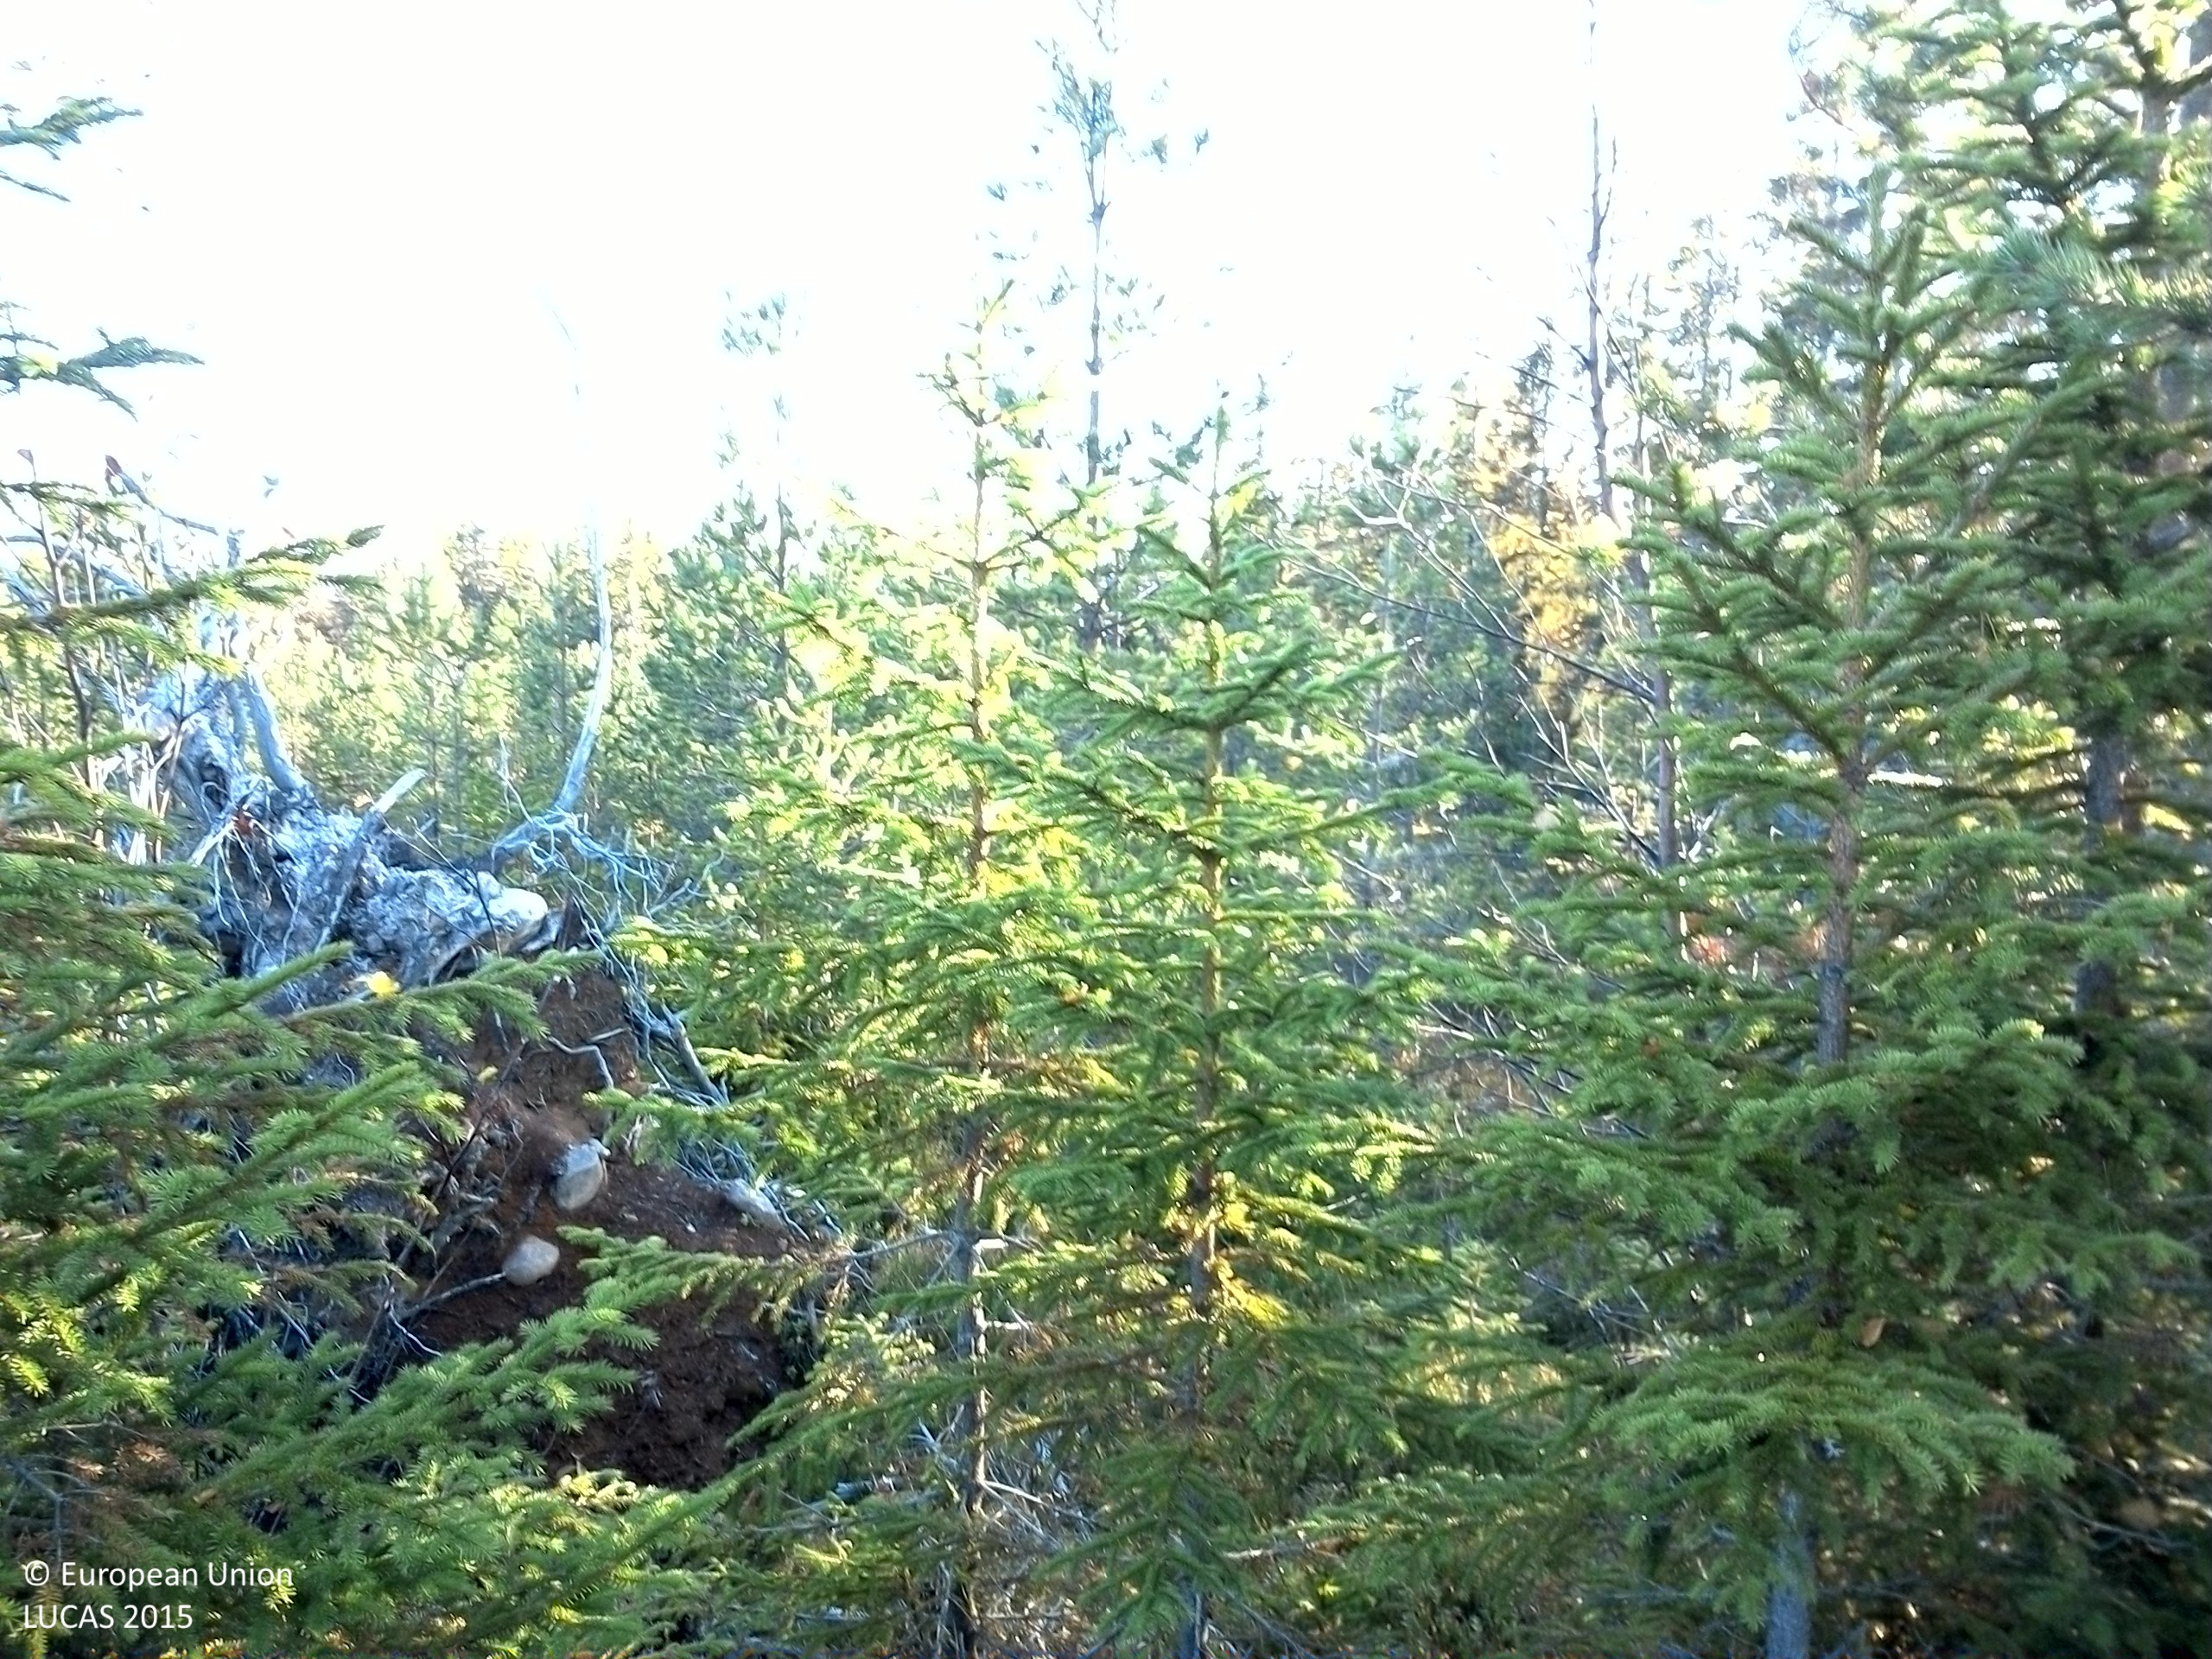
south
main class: Woodland
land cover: Other coniferous woodland
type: boreal forest
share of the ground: 50 - 75 %
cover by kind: coniferous forest trees 60 %, shrubs 25 %, lichens and mosses 10 %, broadleaved forest trees 5 %
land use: Forestry
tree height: < 5 m
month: October
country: SE
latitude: 61.3060
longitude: 14.8583
